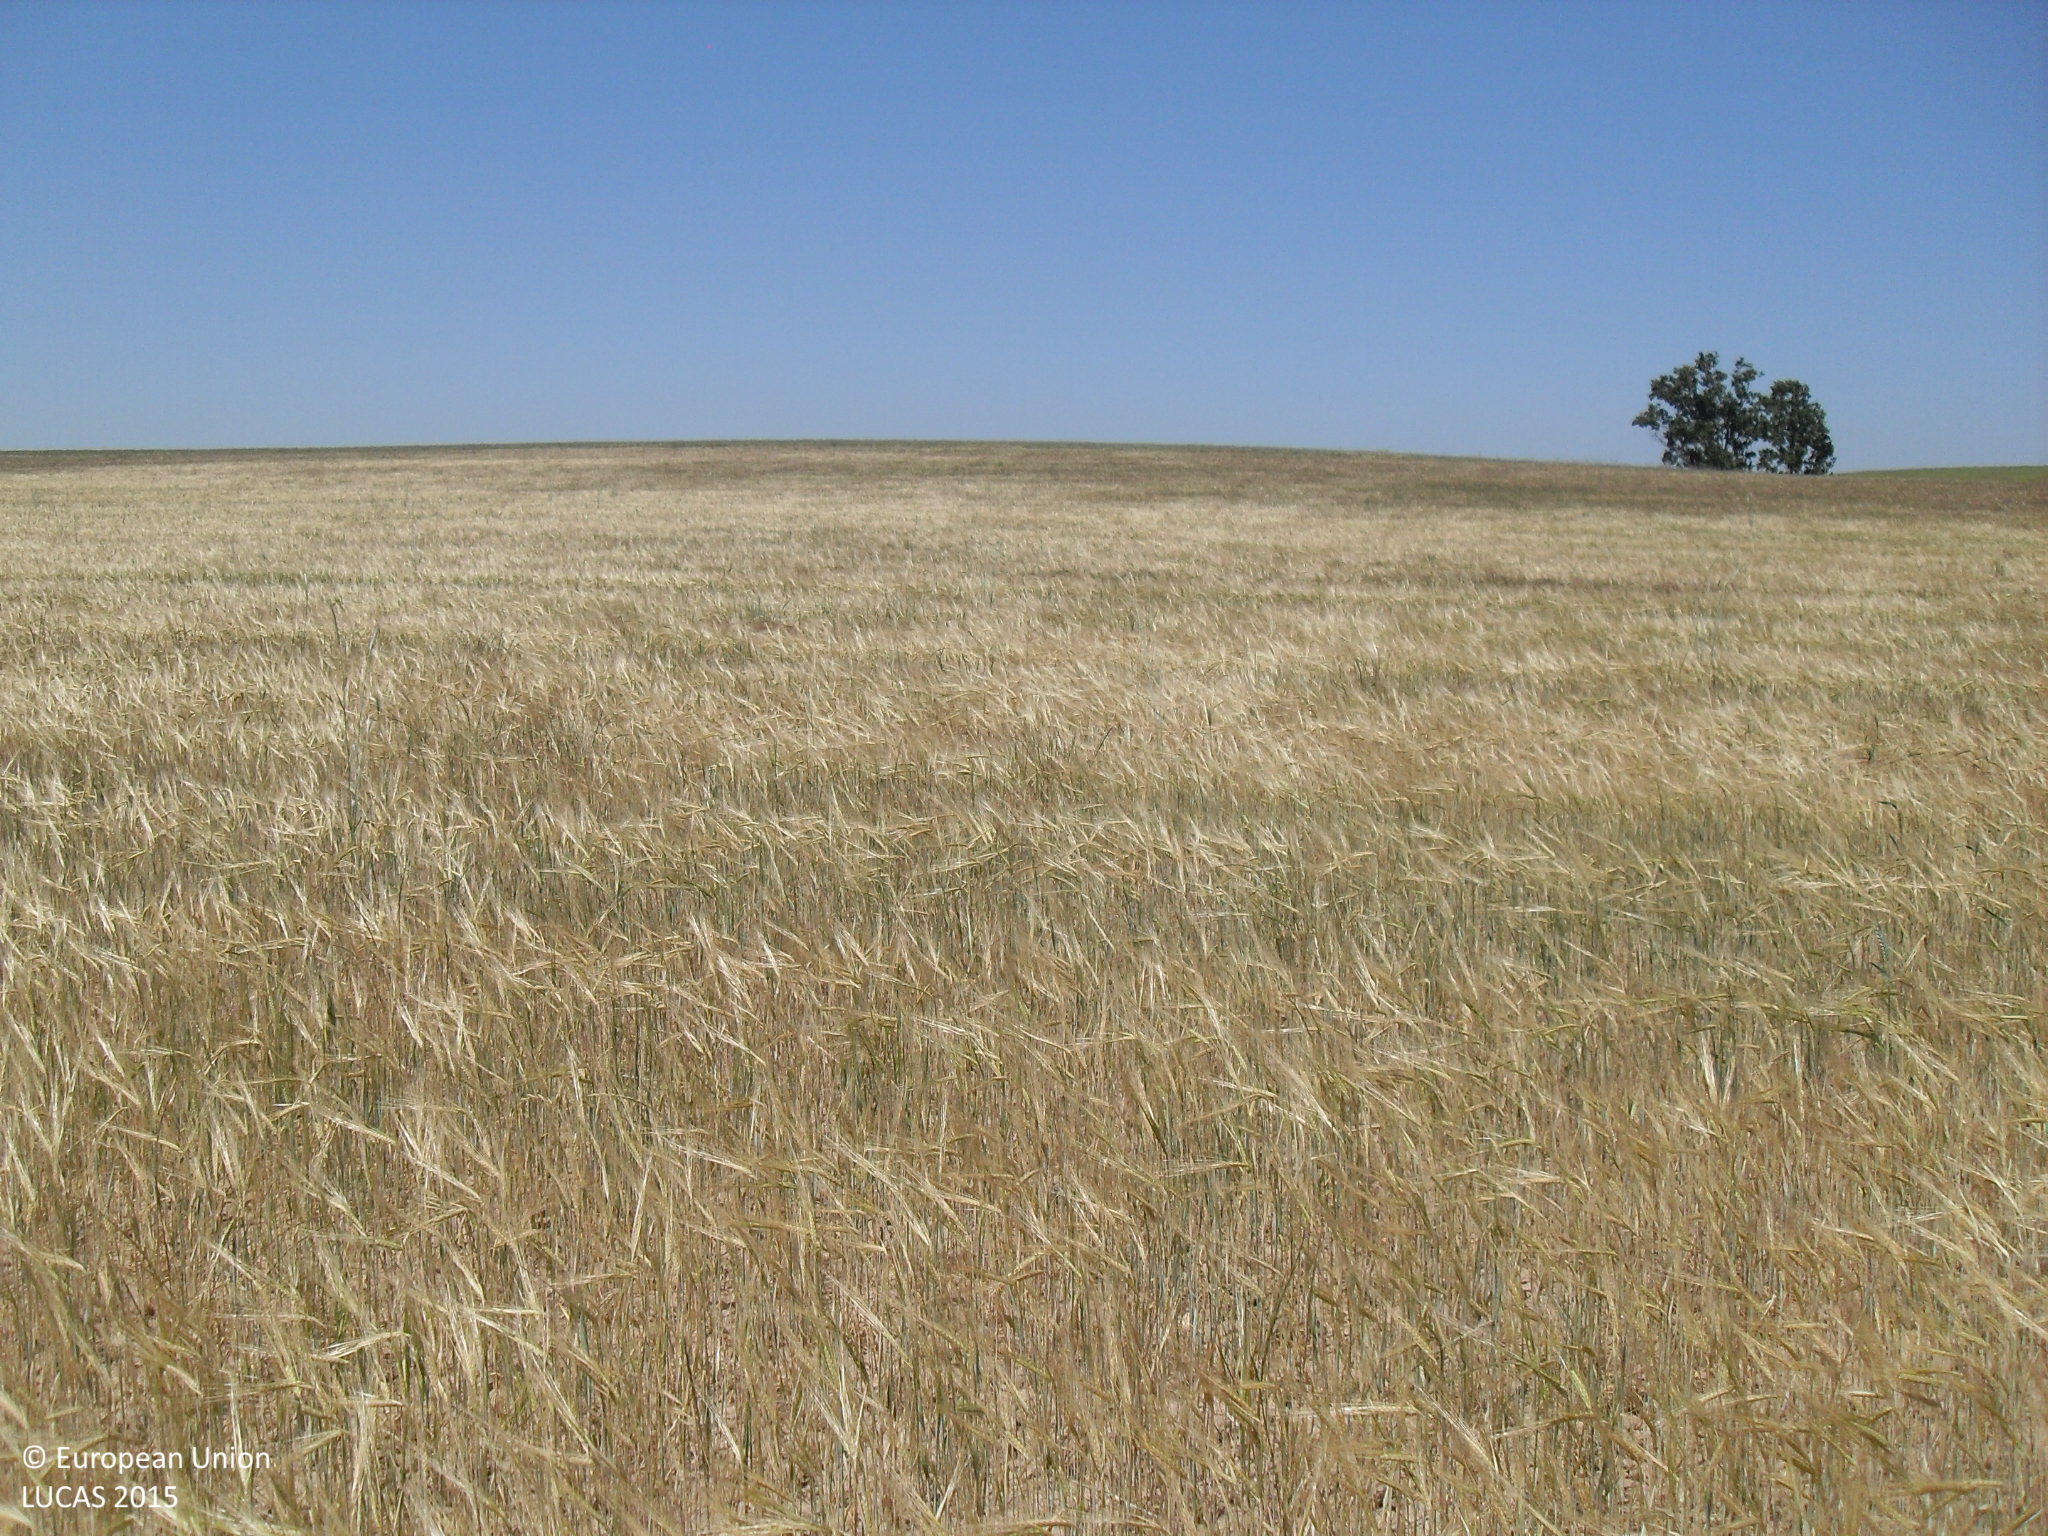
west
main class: Cropland
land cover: Barley
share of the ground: > 75 %
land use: Agriculture (excluding fallow land and kitchen gardens)
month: May
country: ES
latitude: 41.1304
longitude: -5.2111
